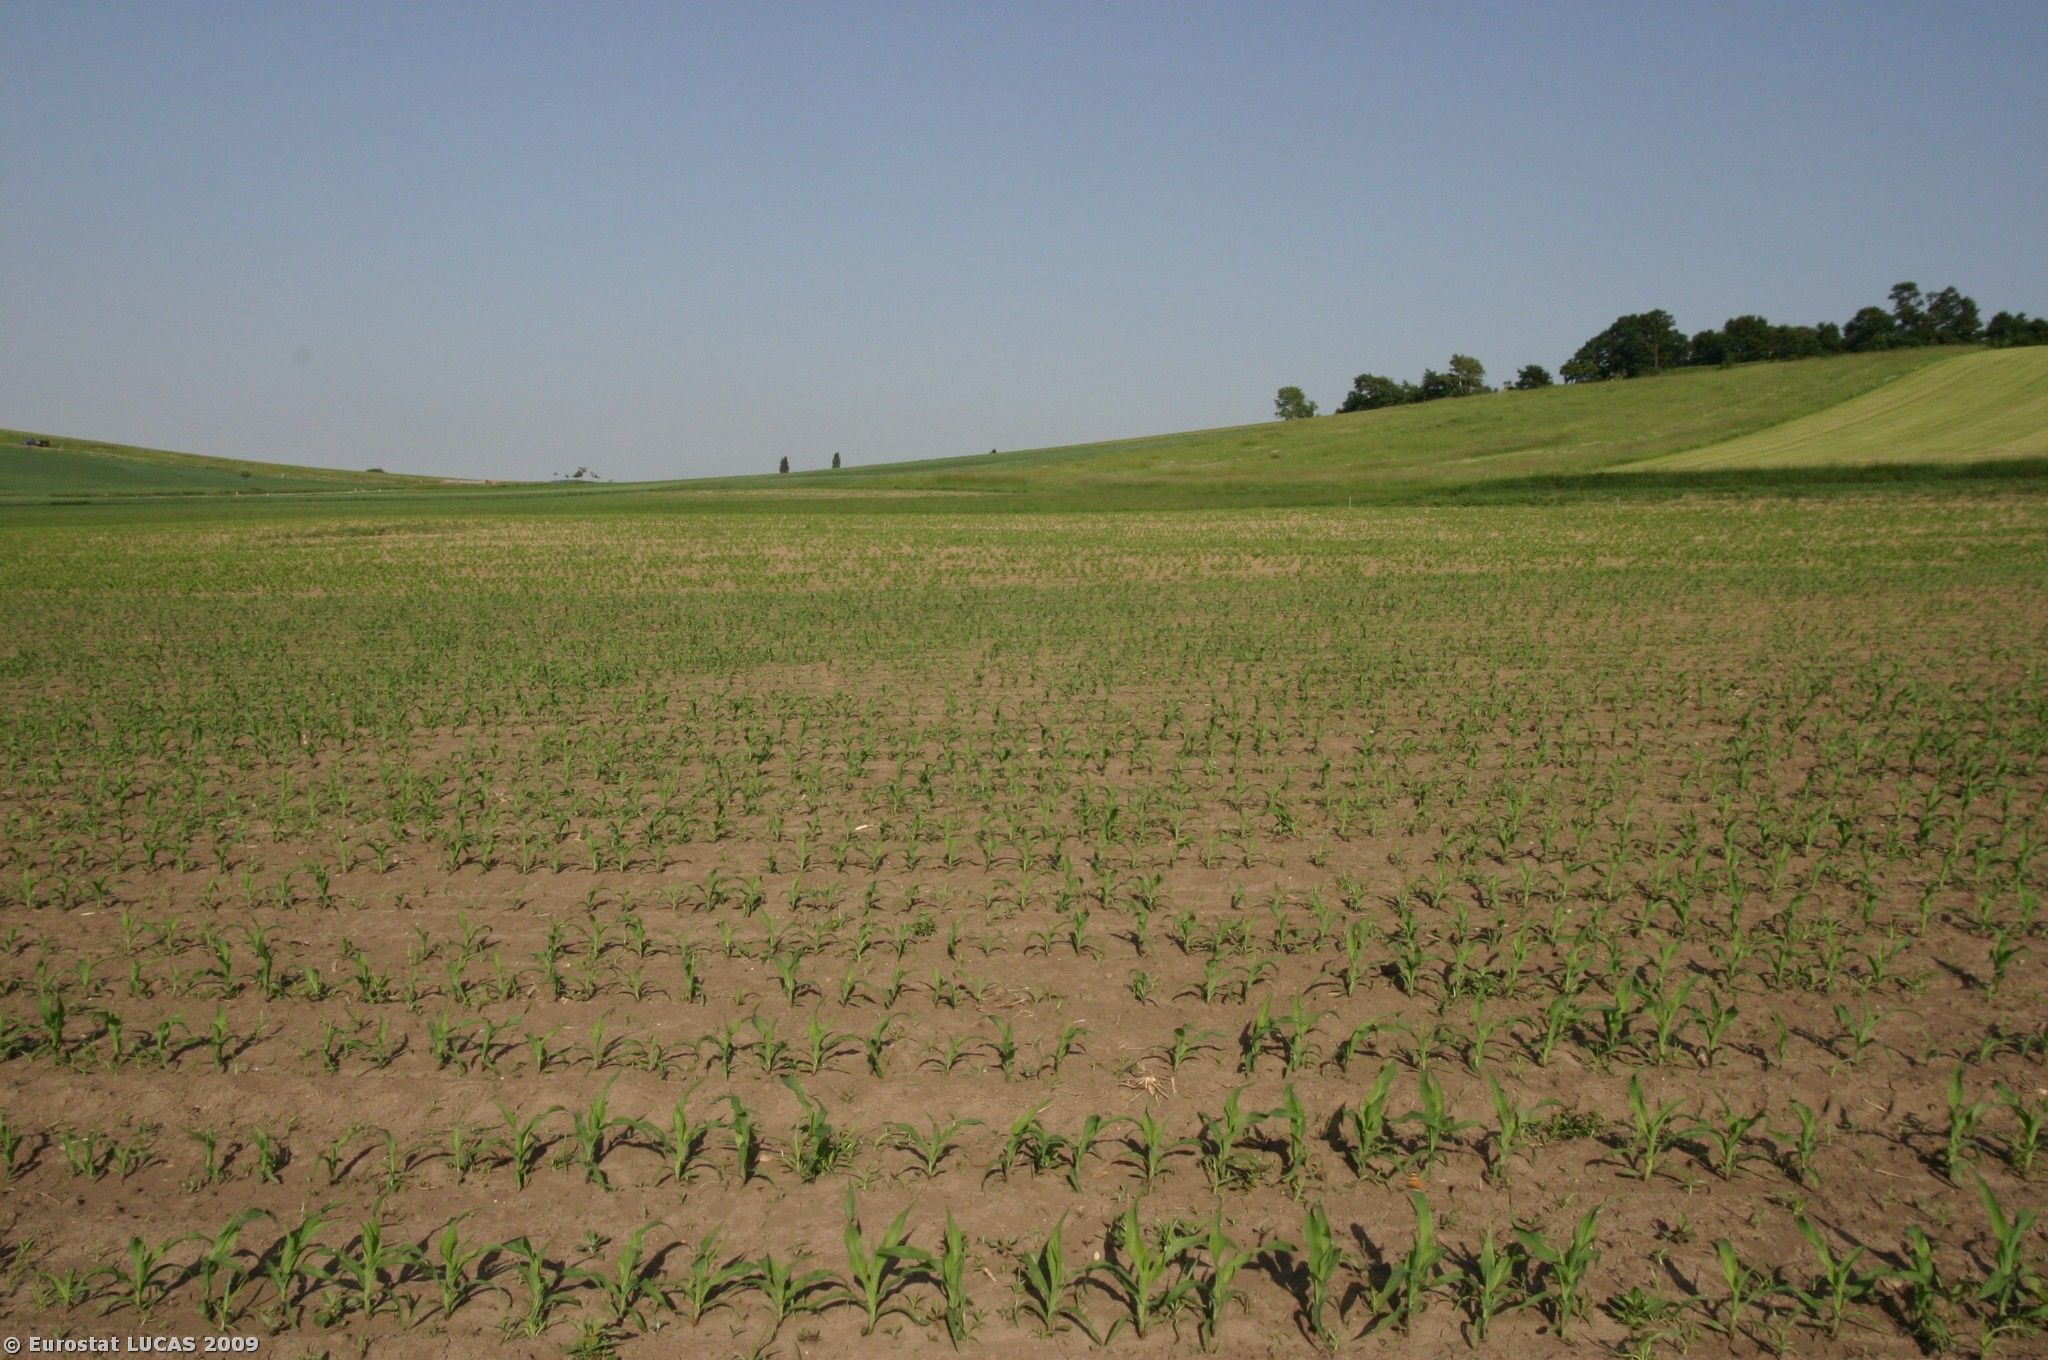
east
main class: Cropland
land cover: Maize
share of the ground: 10 - 25 %
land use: Agriculture (excluding fallow land and kitchen gardens)
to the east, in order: Maize; Sugar beet; Lucerne; Maize; Tracks; Grassland without tree/shrub cover; Common wheat; Sugar beet
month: May
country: AT
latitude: 48.2243
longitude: 15.9669
